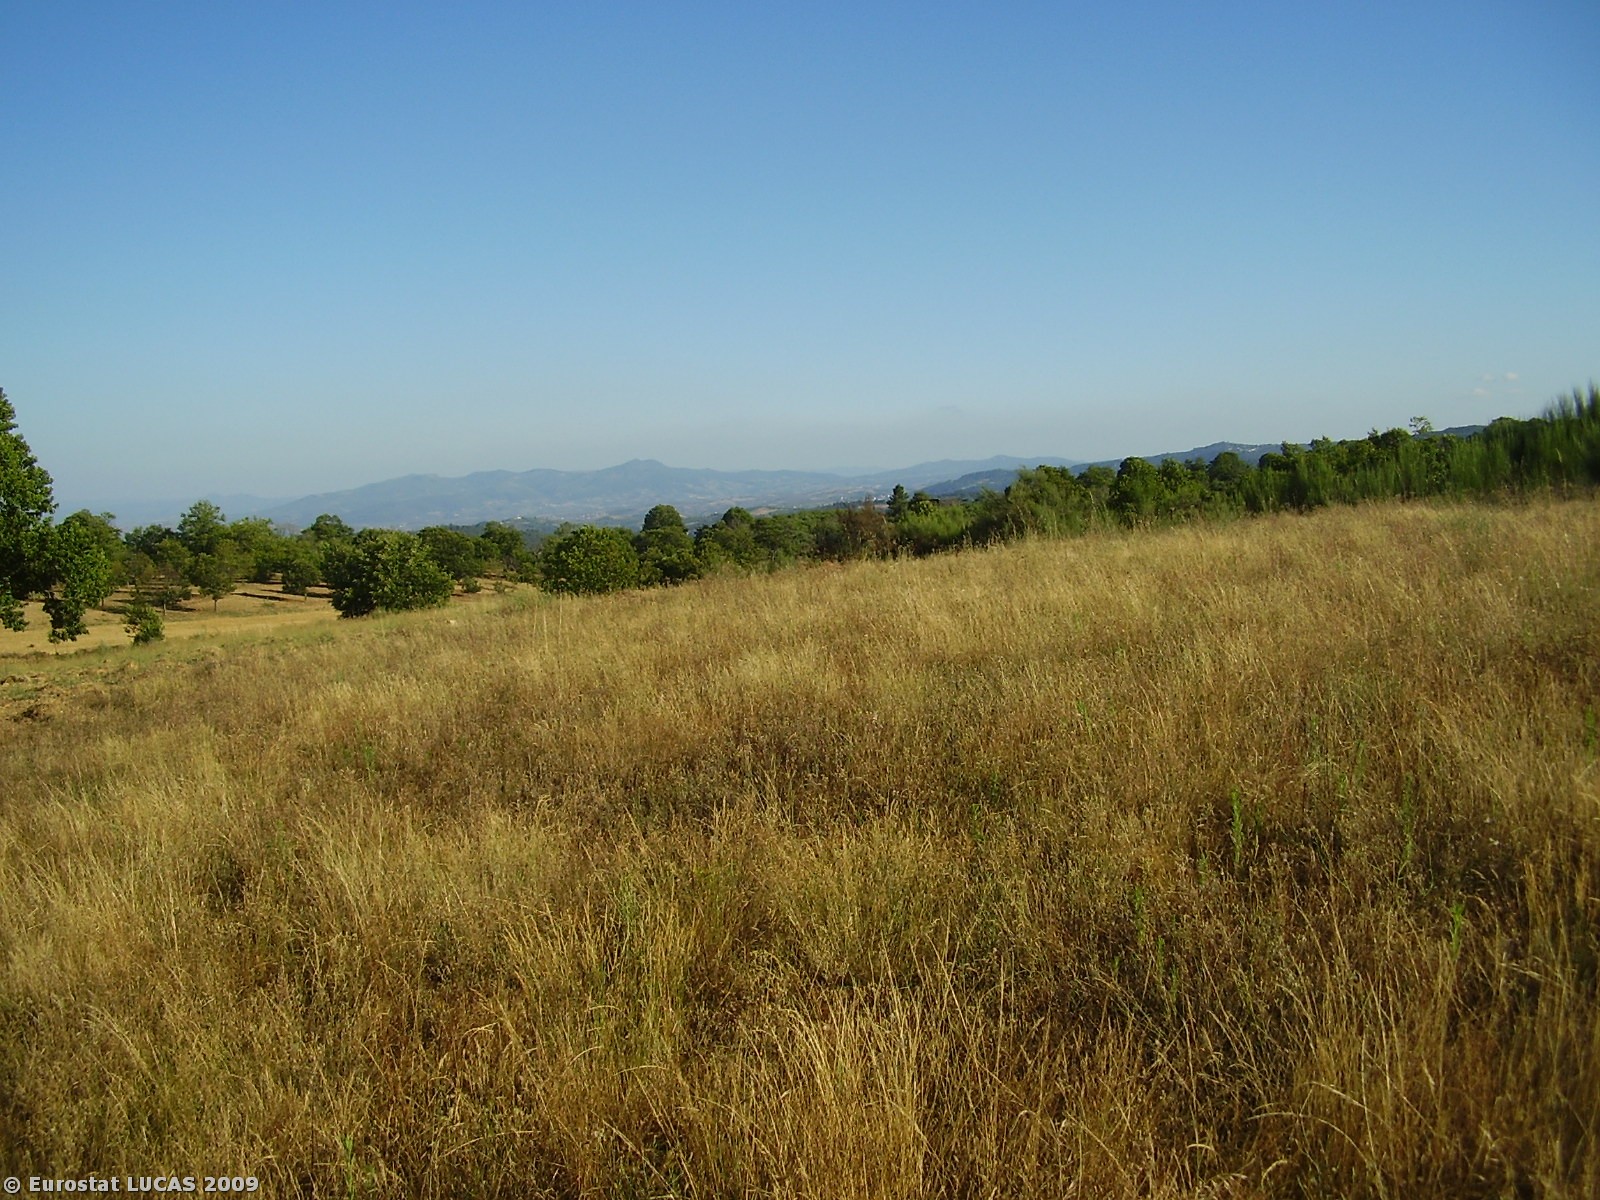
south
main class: Grassland
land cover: Spontaneously vegetated surfaces
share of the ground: > 75 %
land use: Unused
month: July
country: PT
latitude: 41.6887
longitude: -7.3920
